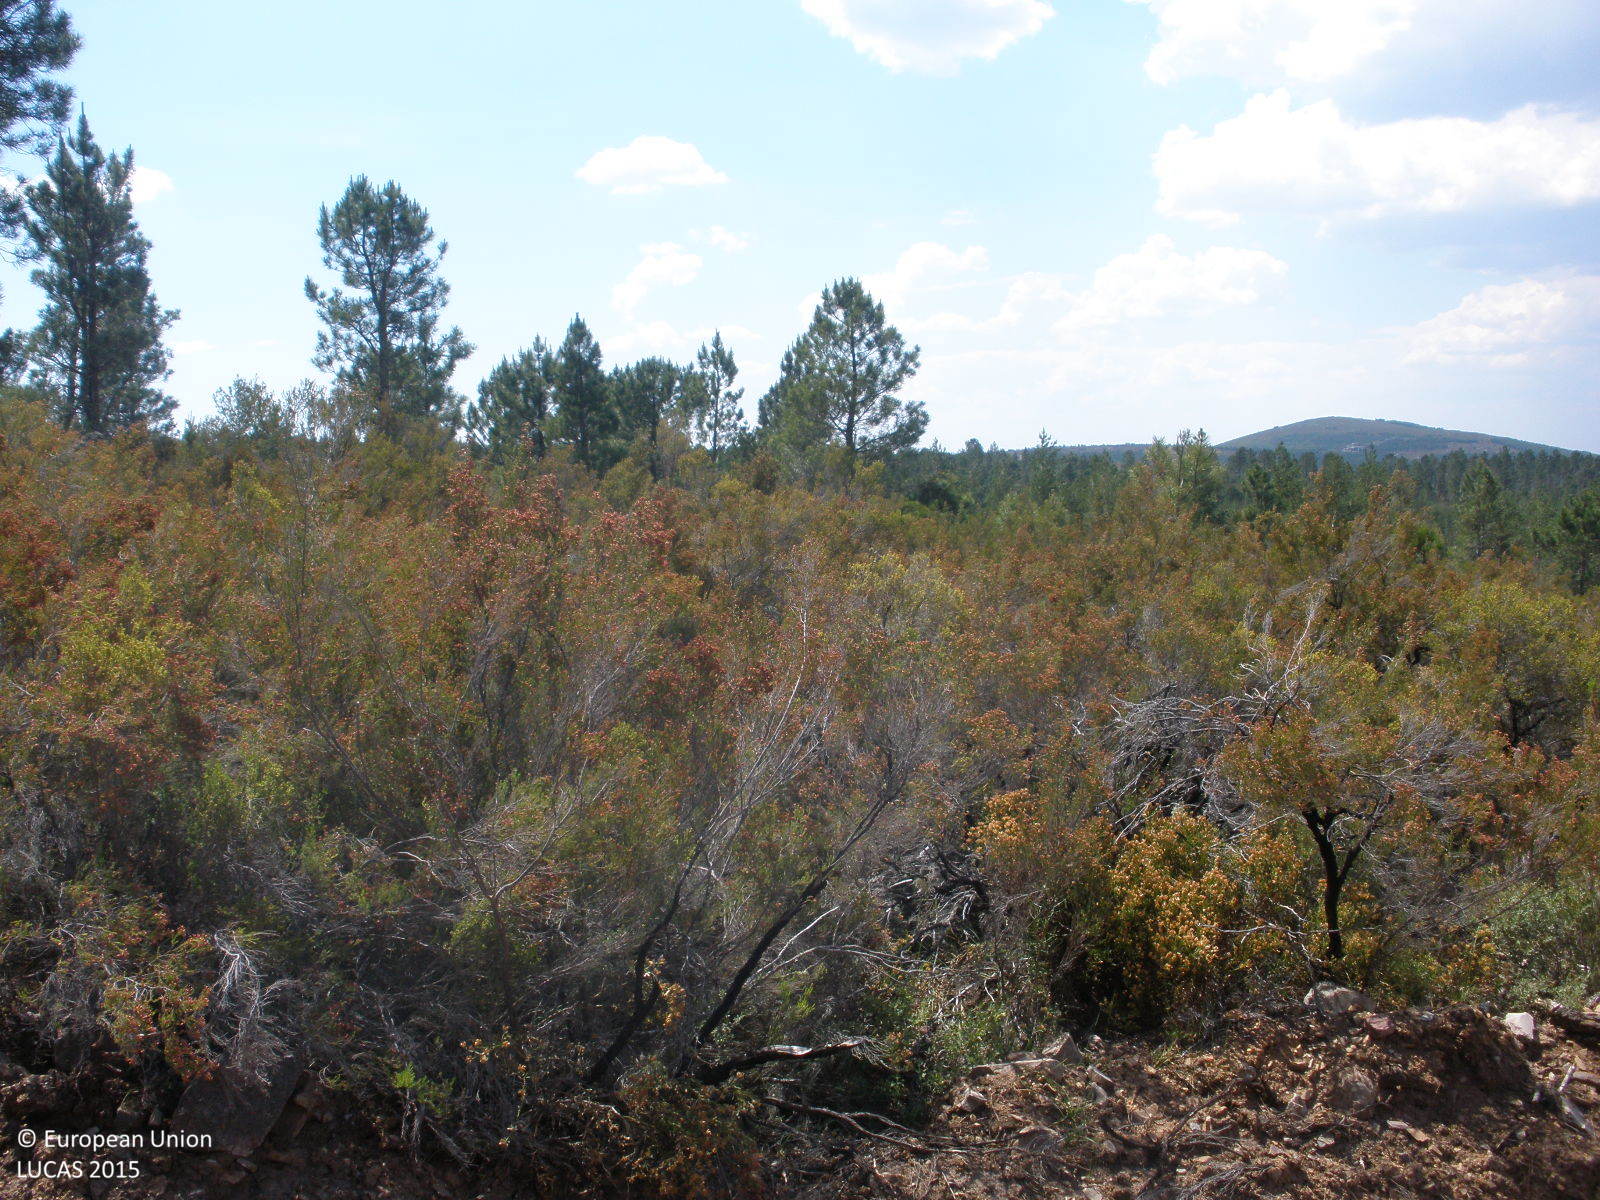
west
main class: Woodland
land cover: Pine dominated coniferous woodland
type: coniferous forest of the mediterranean region
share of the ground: > 75 %
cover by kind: shrubs 80 %, coniferous forest trees 20 %
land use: Forestry
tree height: > 5 m
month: June
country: ES
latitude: 40.5373
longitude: -6.2696
